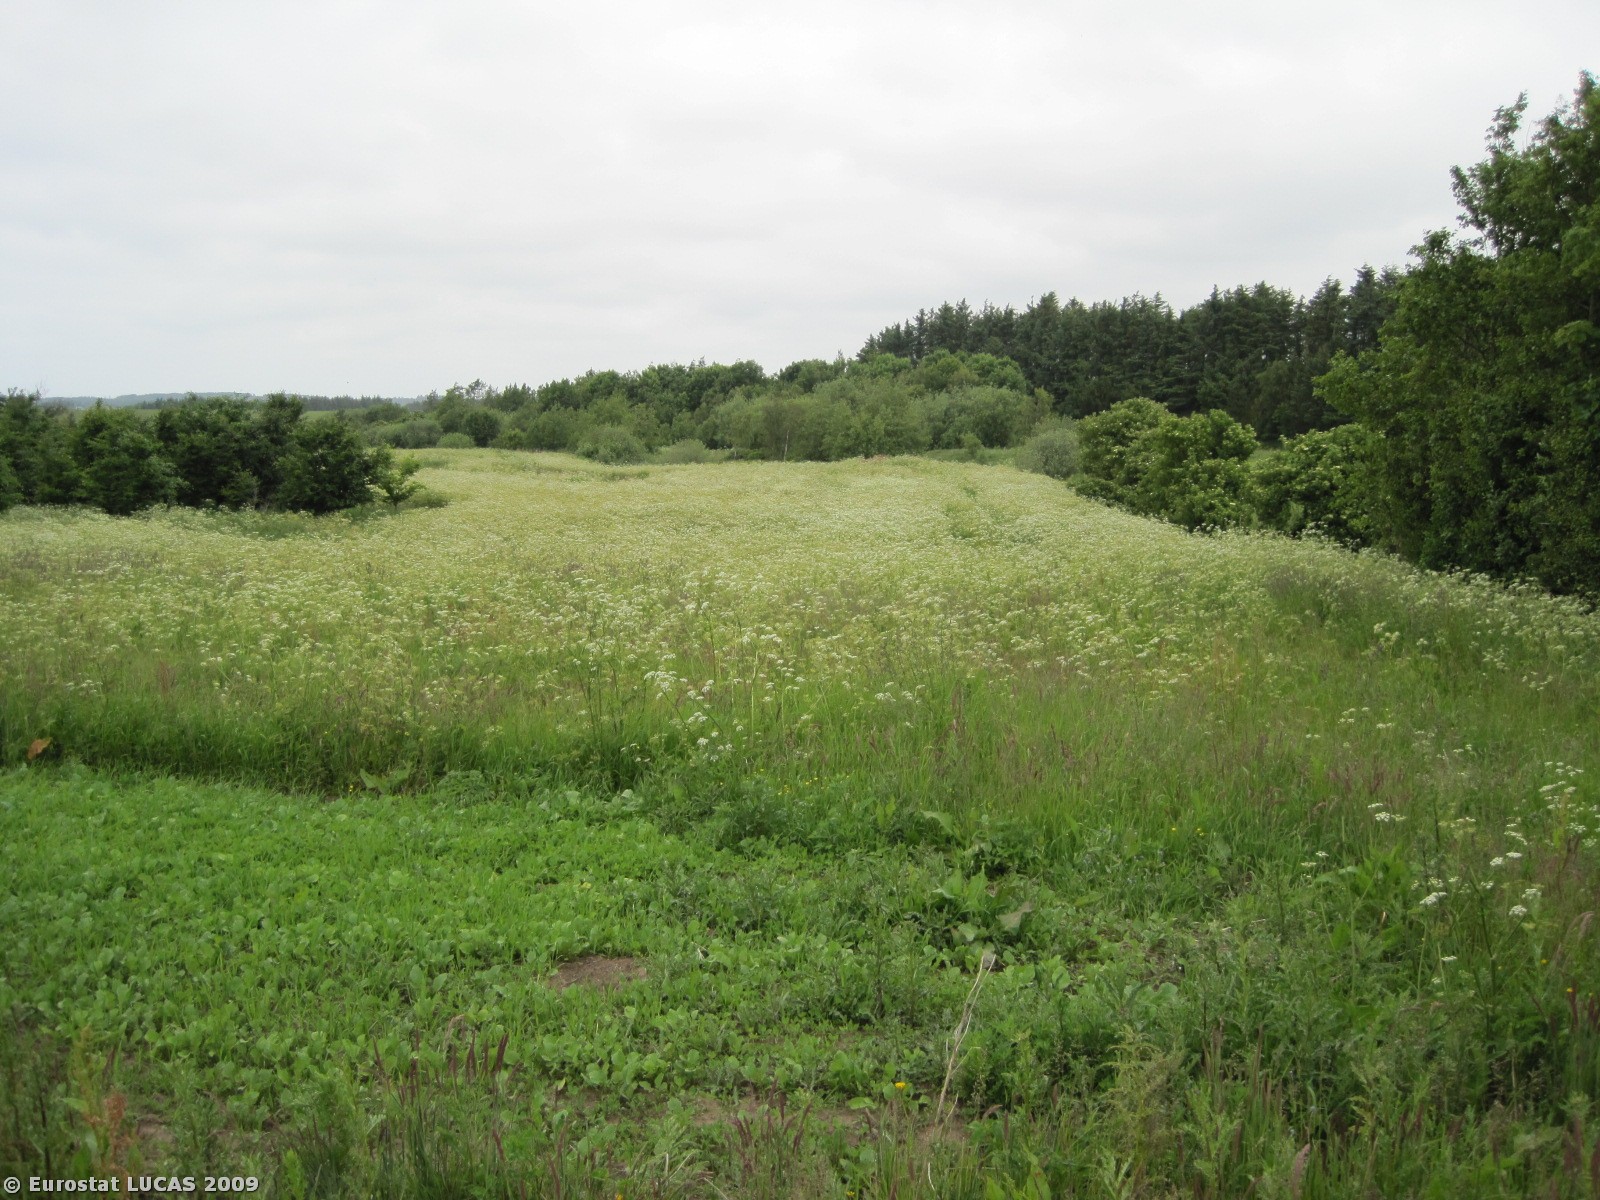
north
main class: Grassland
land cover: Grassland without tree/shrub cover
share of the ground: > 75 %
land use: Unused
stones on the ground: < 10 %
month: June
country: DK
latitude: 57.2124
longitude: 10.1157
